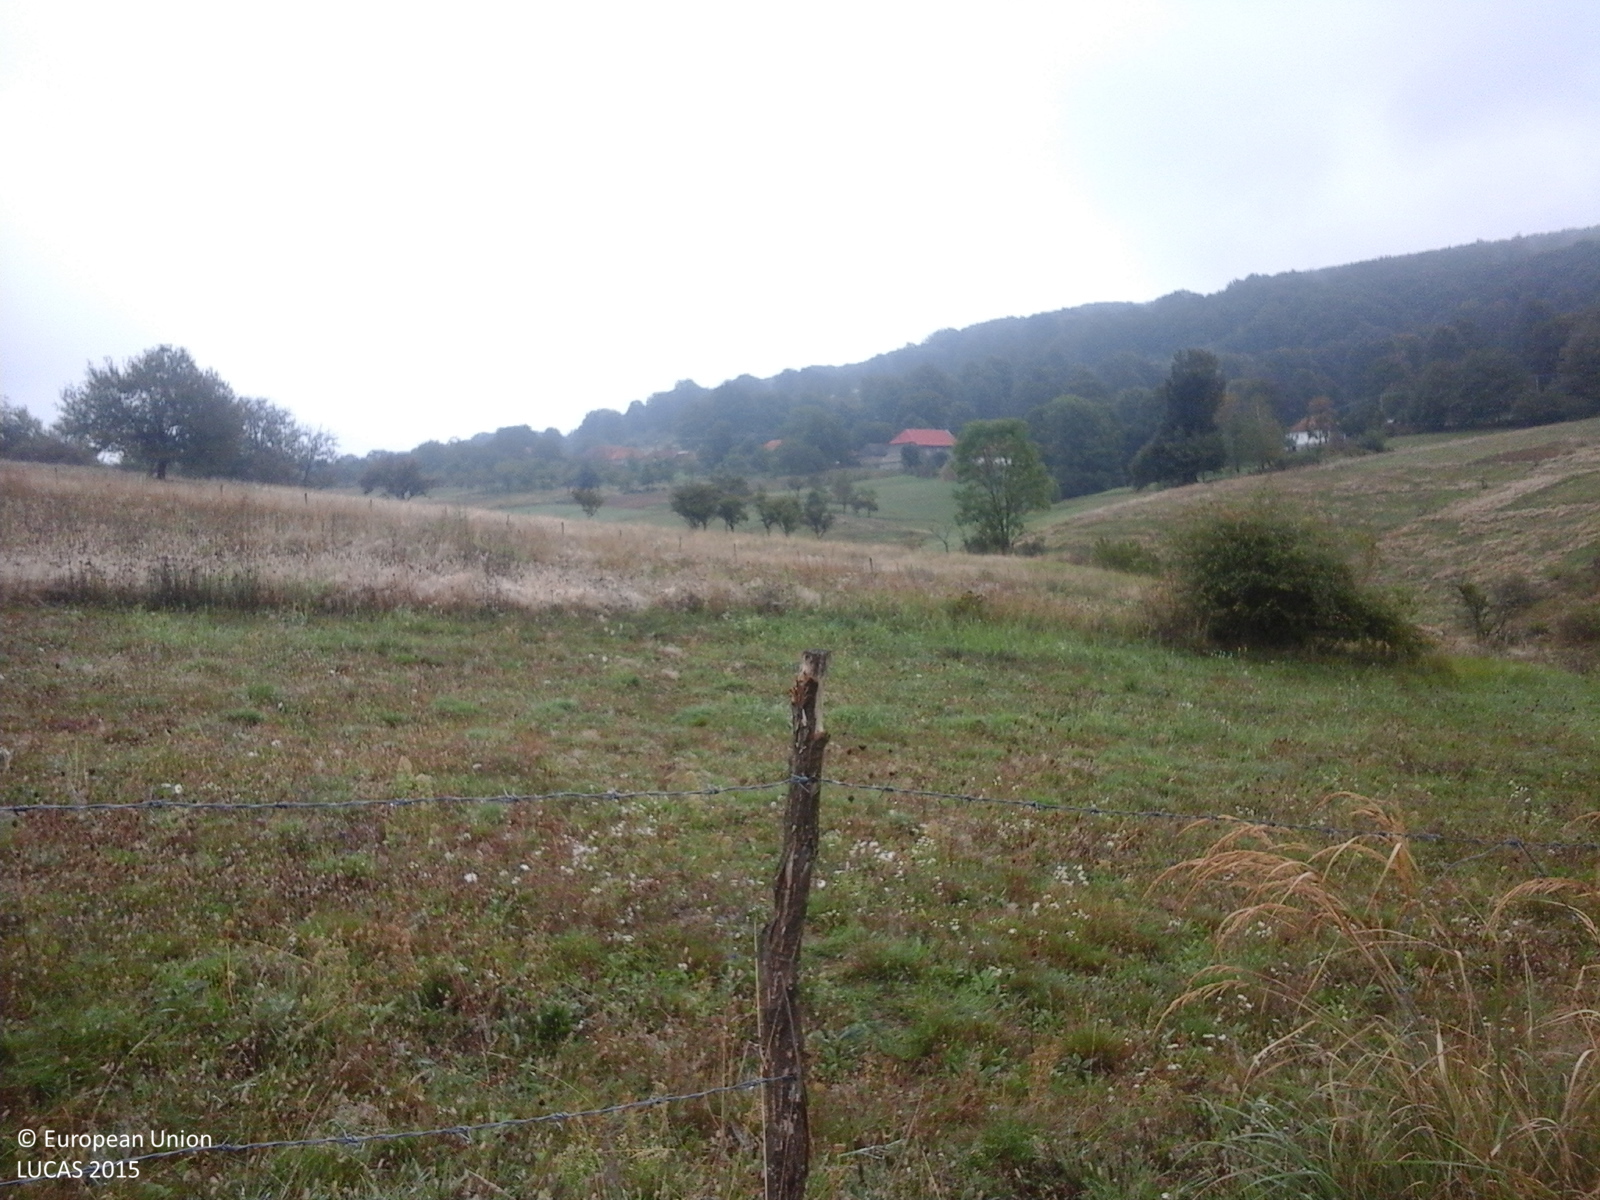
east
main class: Grassland
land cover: Grassland without tree/shrub cover
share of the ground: > 75 %
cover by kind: herbaceous plants 100 %
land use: Agriculture (excluding fallow land and kitchen gardens)
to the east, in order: Grassland without tree/shrub cover; Broadleaved woodland; Grassland without tree/shrub cover
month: September
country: RO
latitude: 46.9124
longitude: 22.4608
